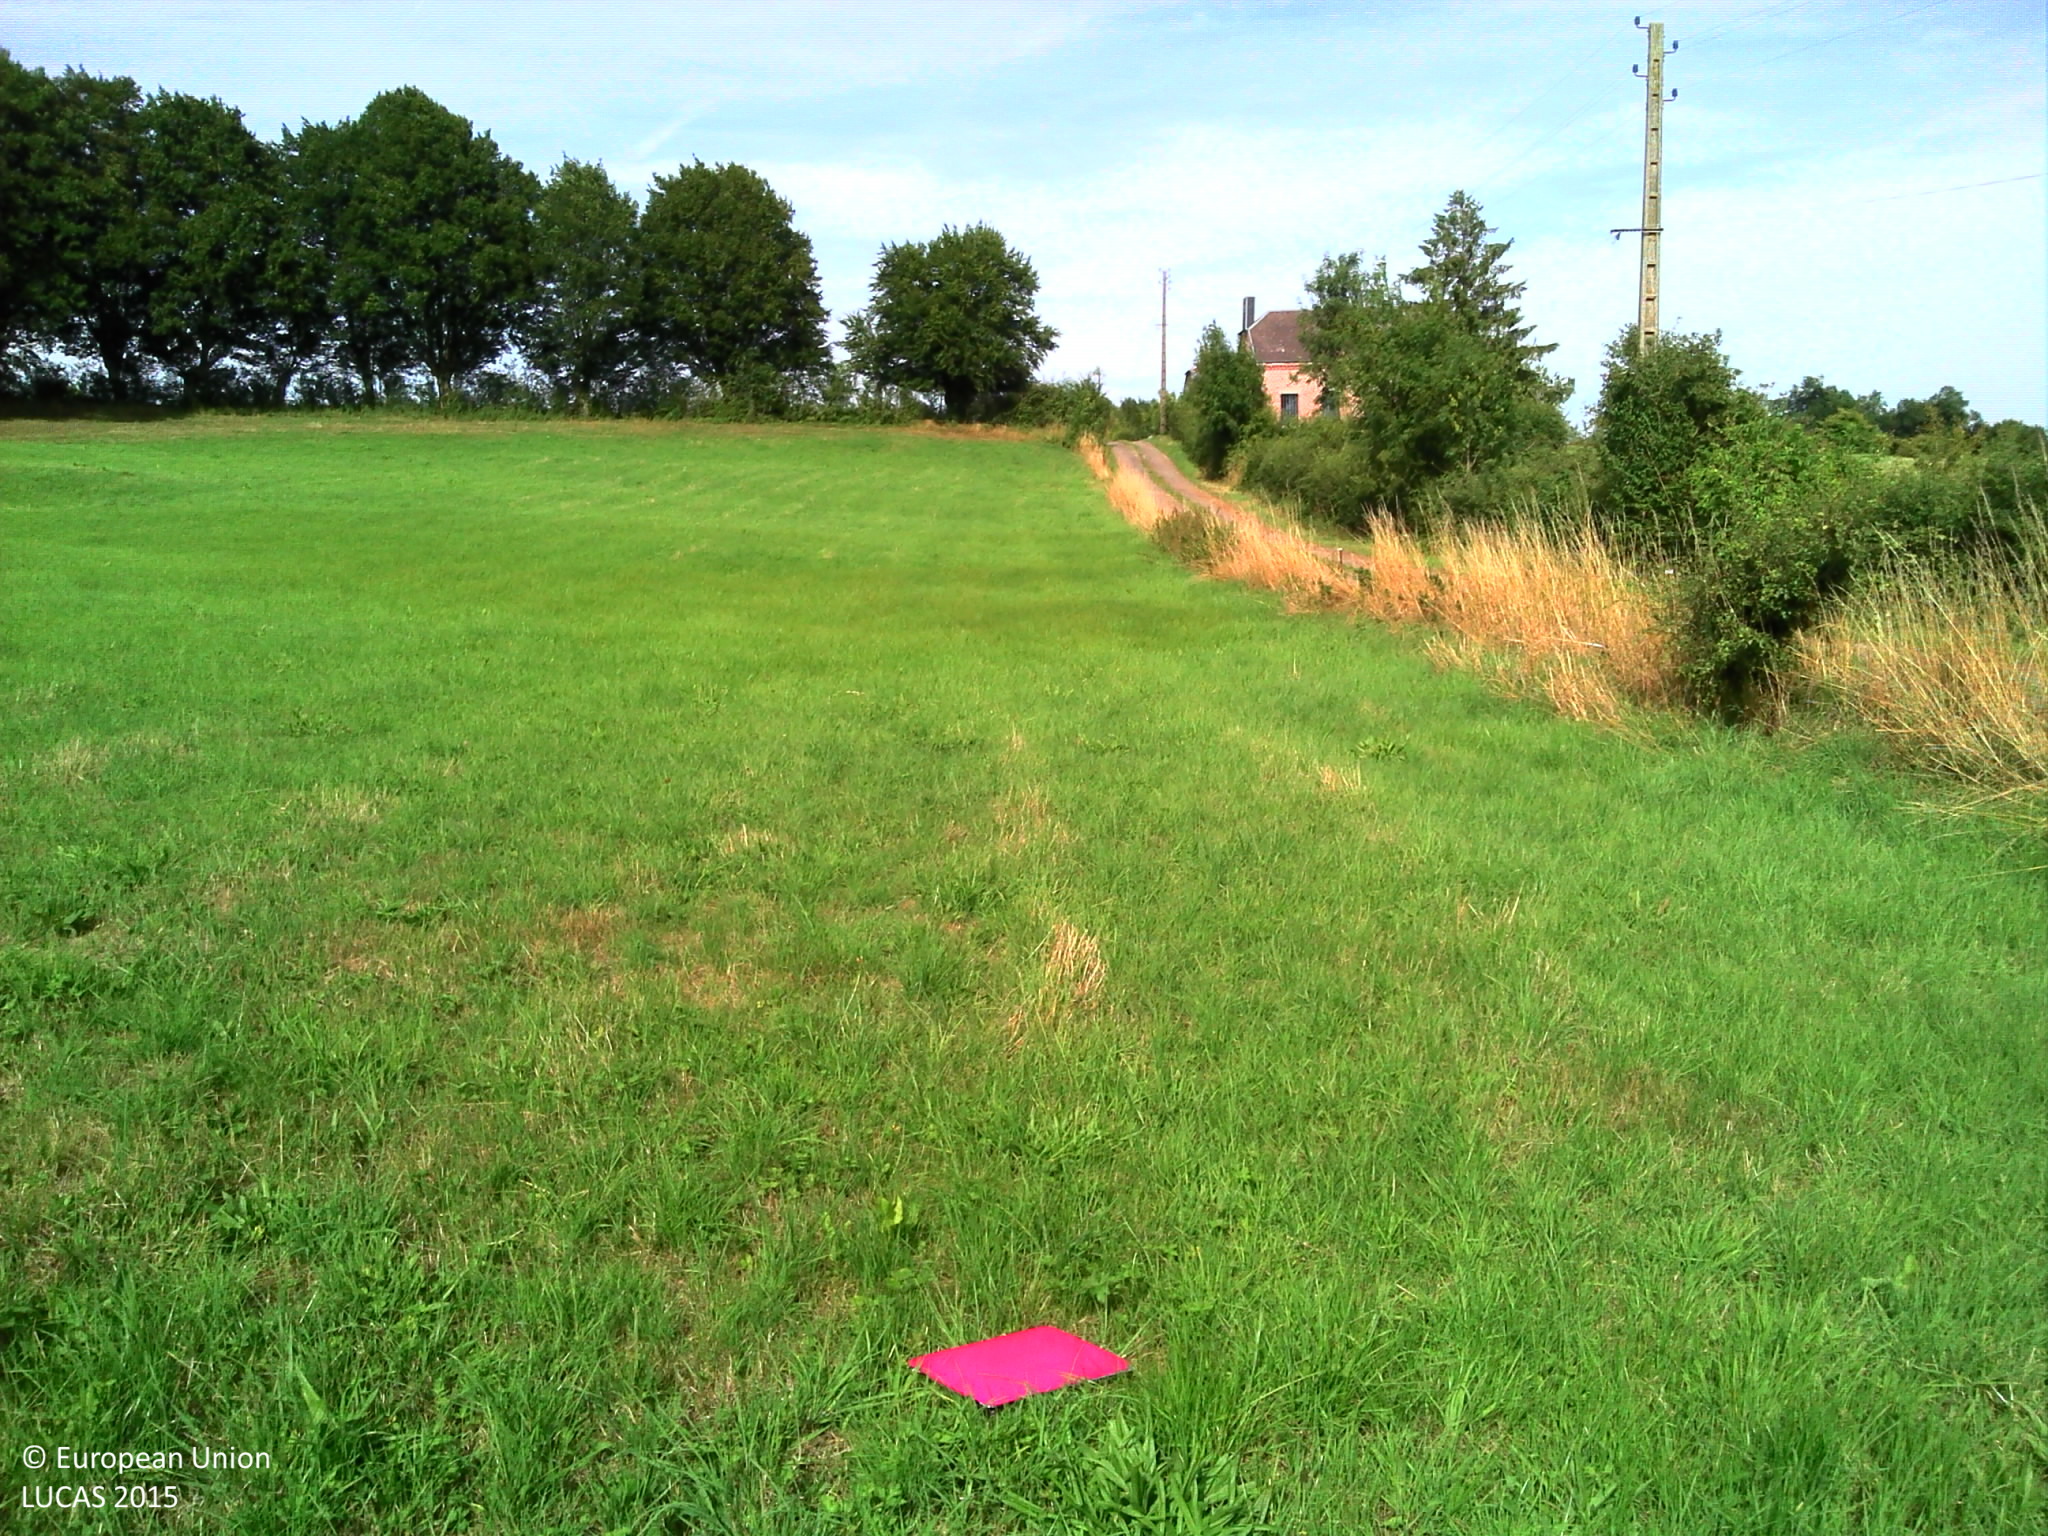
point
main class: Grassland
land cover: Grassland without tree/shrub cover
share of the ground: > 75 %
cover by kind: herbaceous plants 95 %, lichens and mosses 5 %
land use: Agriculture (excluding fallow land and kitchen gardens)
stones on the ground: < 10 %
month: August
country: FR
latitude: 50.0788
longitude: 3.9715
